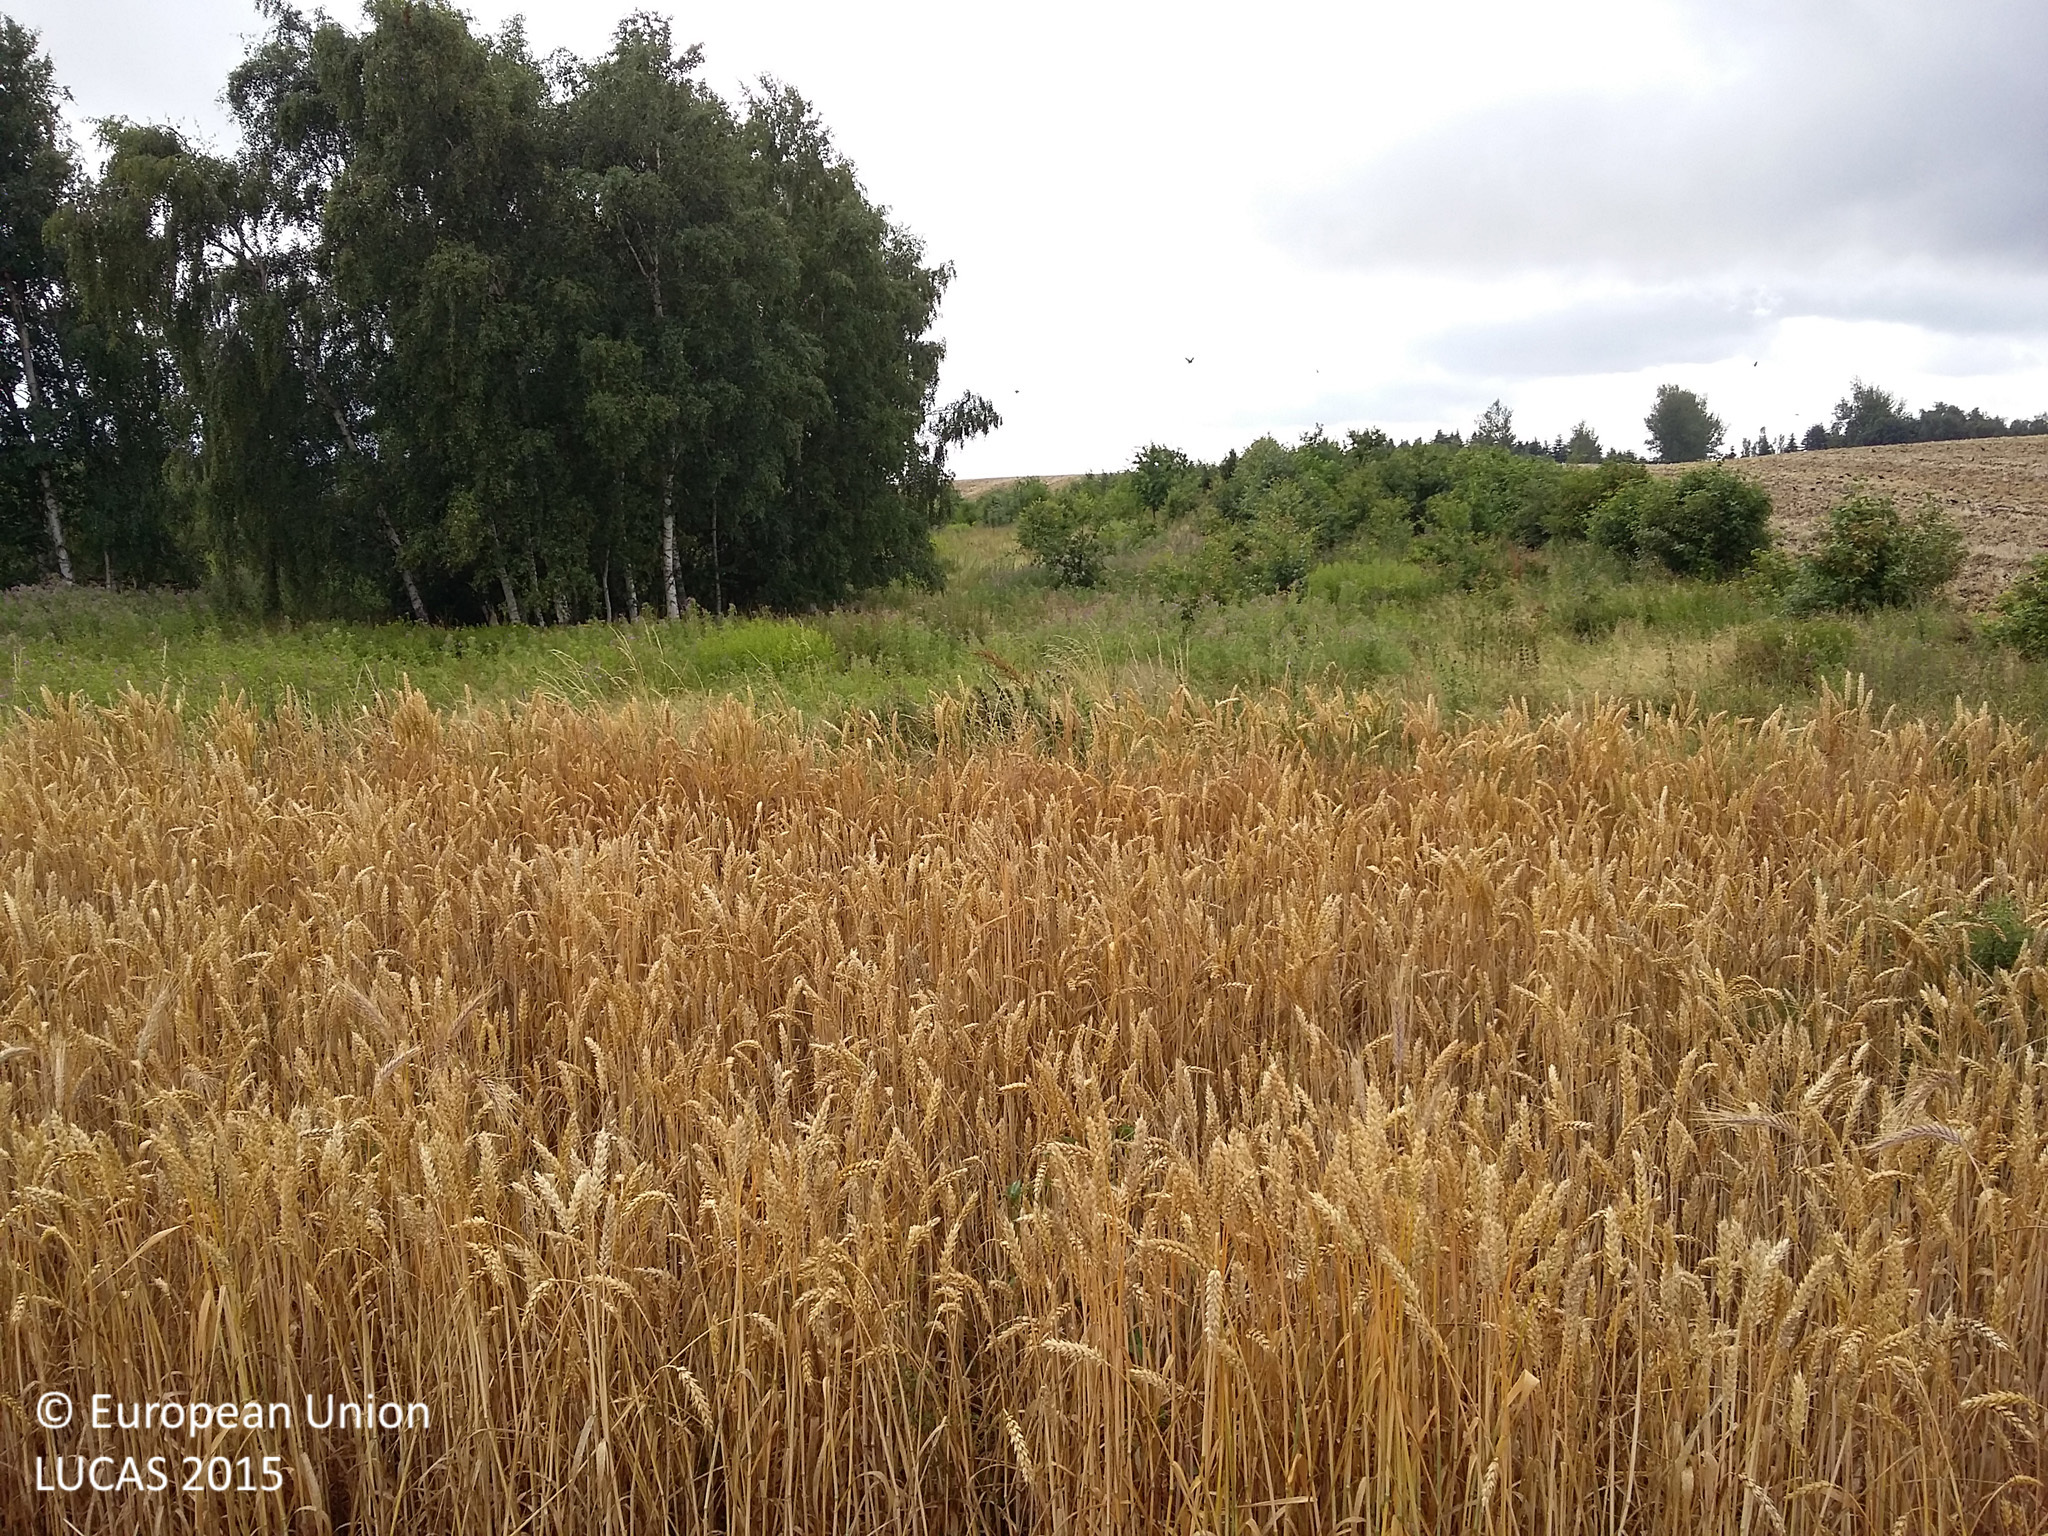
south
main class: Cropland
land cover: Common wheat
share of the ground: > 75 %
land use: Agriculture (excluding fallow land and kitchen gardens)
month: July
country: DK
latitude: 55.7741
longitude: 12.1502
